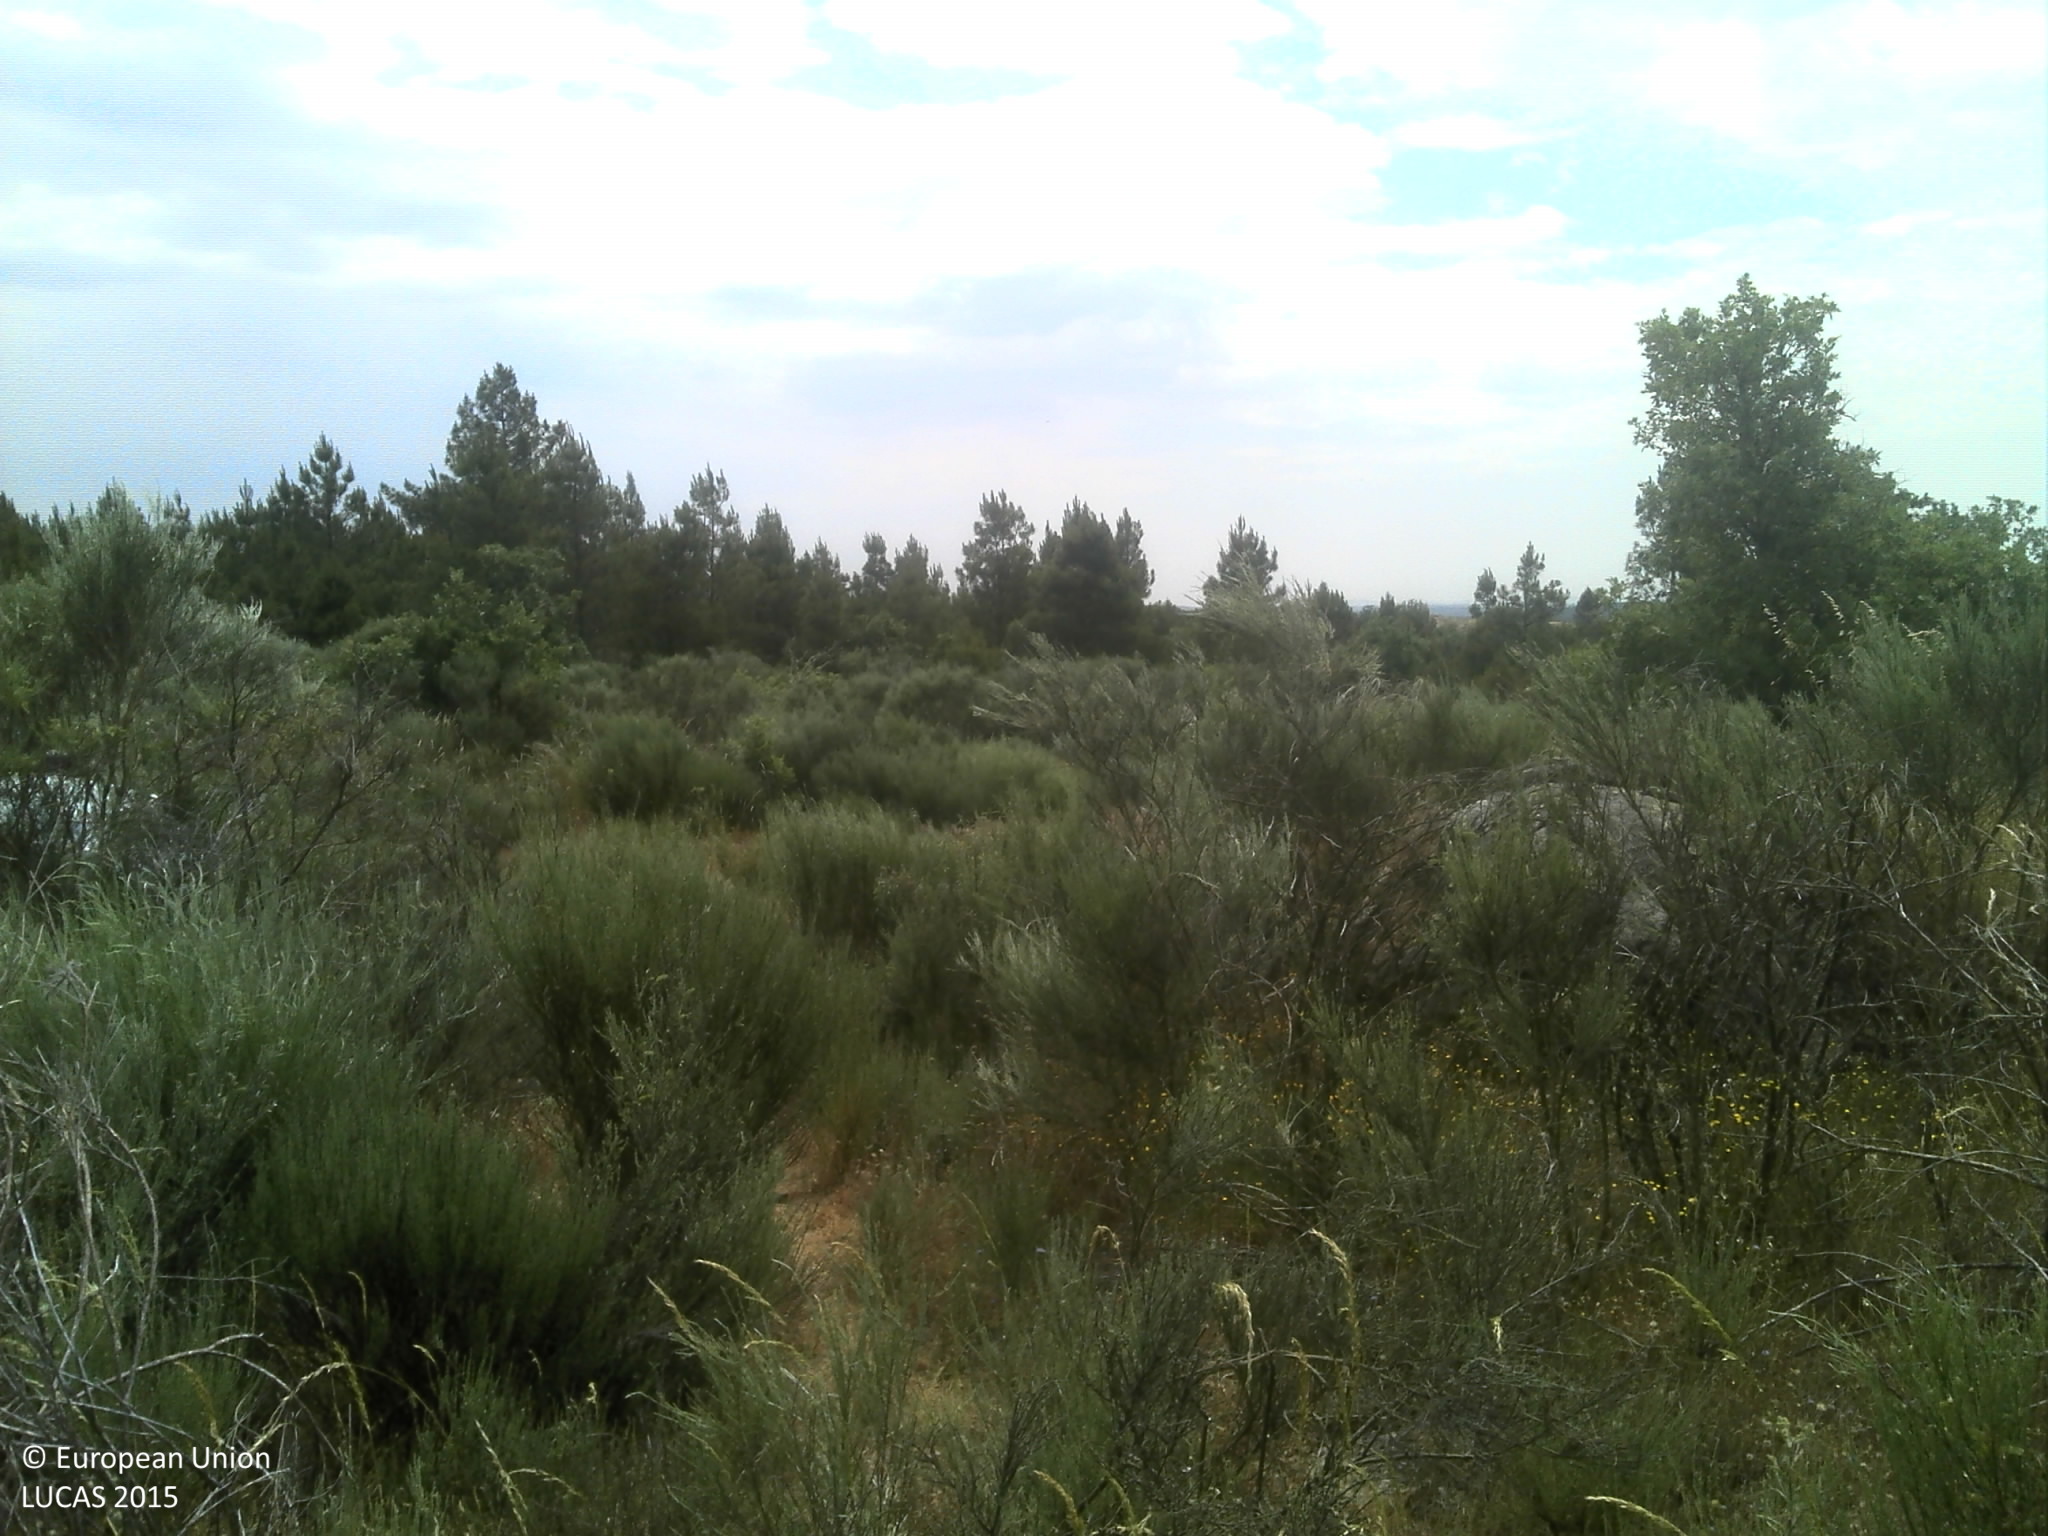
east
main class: Shrubland
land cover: Shrubland with sparse tree cover
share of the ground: 50 - 75 %
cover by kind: shrubs 75 %, unconsolidated bare surface 20 %, broadleaved forest trees 5 %
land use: Semi-natural and natural areas not in use
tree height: < 5 m
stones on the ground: 25 - 50 %
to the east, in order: Shrubland with sparse tree cover; Shrubland without tree cover; Other structural elements; Shrubland without tree cover; Rocks and stones; Pine dominated coniferous woodland; Grassland without tree/shrub cover; Shrubland without tree cover; Other structural elements; Dry stone walls; Shrubland without tree cover; Rocks and stones; Shrubland with sparse tree cover; Tracks; Shrubland with sparse tree cover
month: June
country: PT
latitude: 40.5218
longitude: -7.1108
